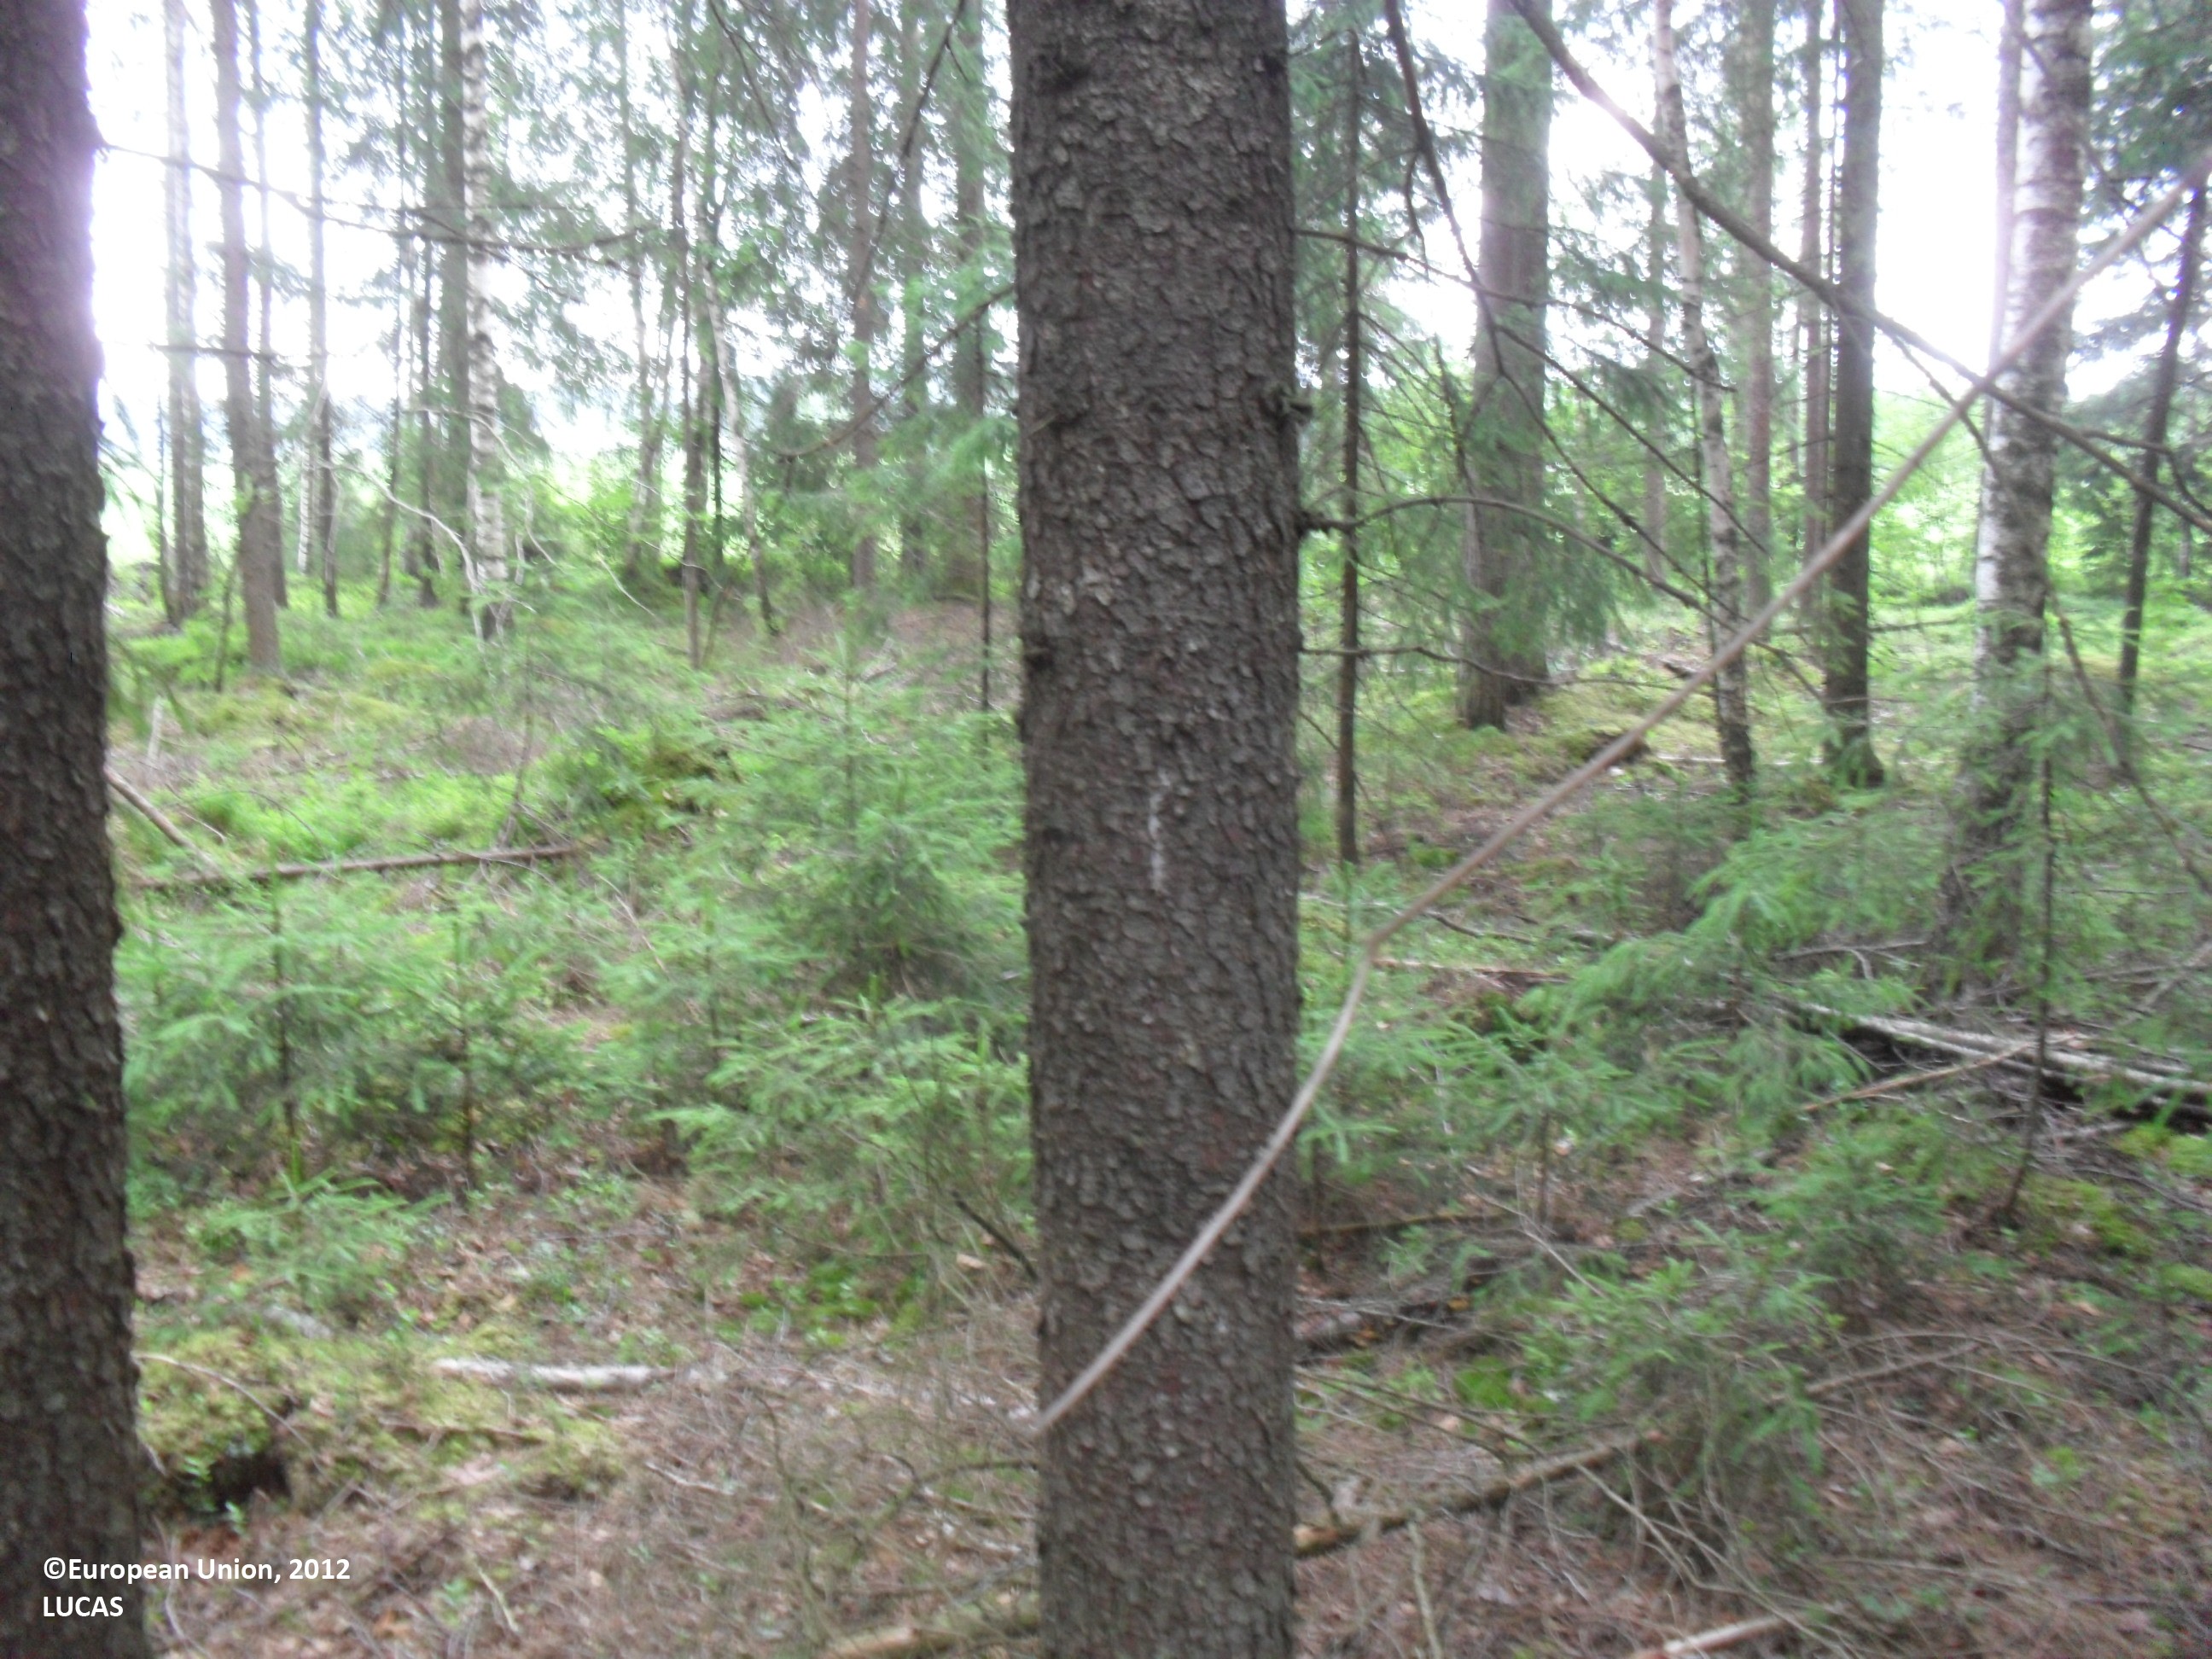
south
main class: Woodland
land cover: Spruce dominated mixed woodland
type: boreal forest
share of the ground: 50 - 75 %
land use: Forestry
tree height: > 5 m
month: July
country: FI
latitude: 63.6324
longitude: 23.5219
